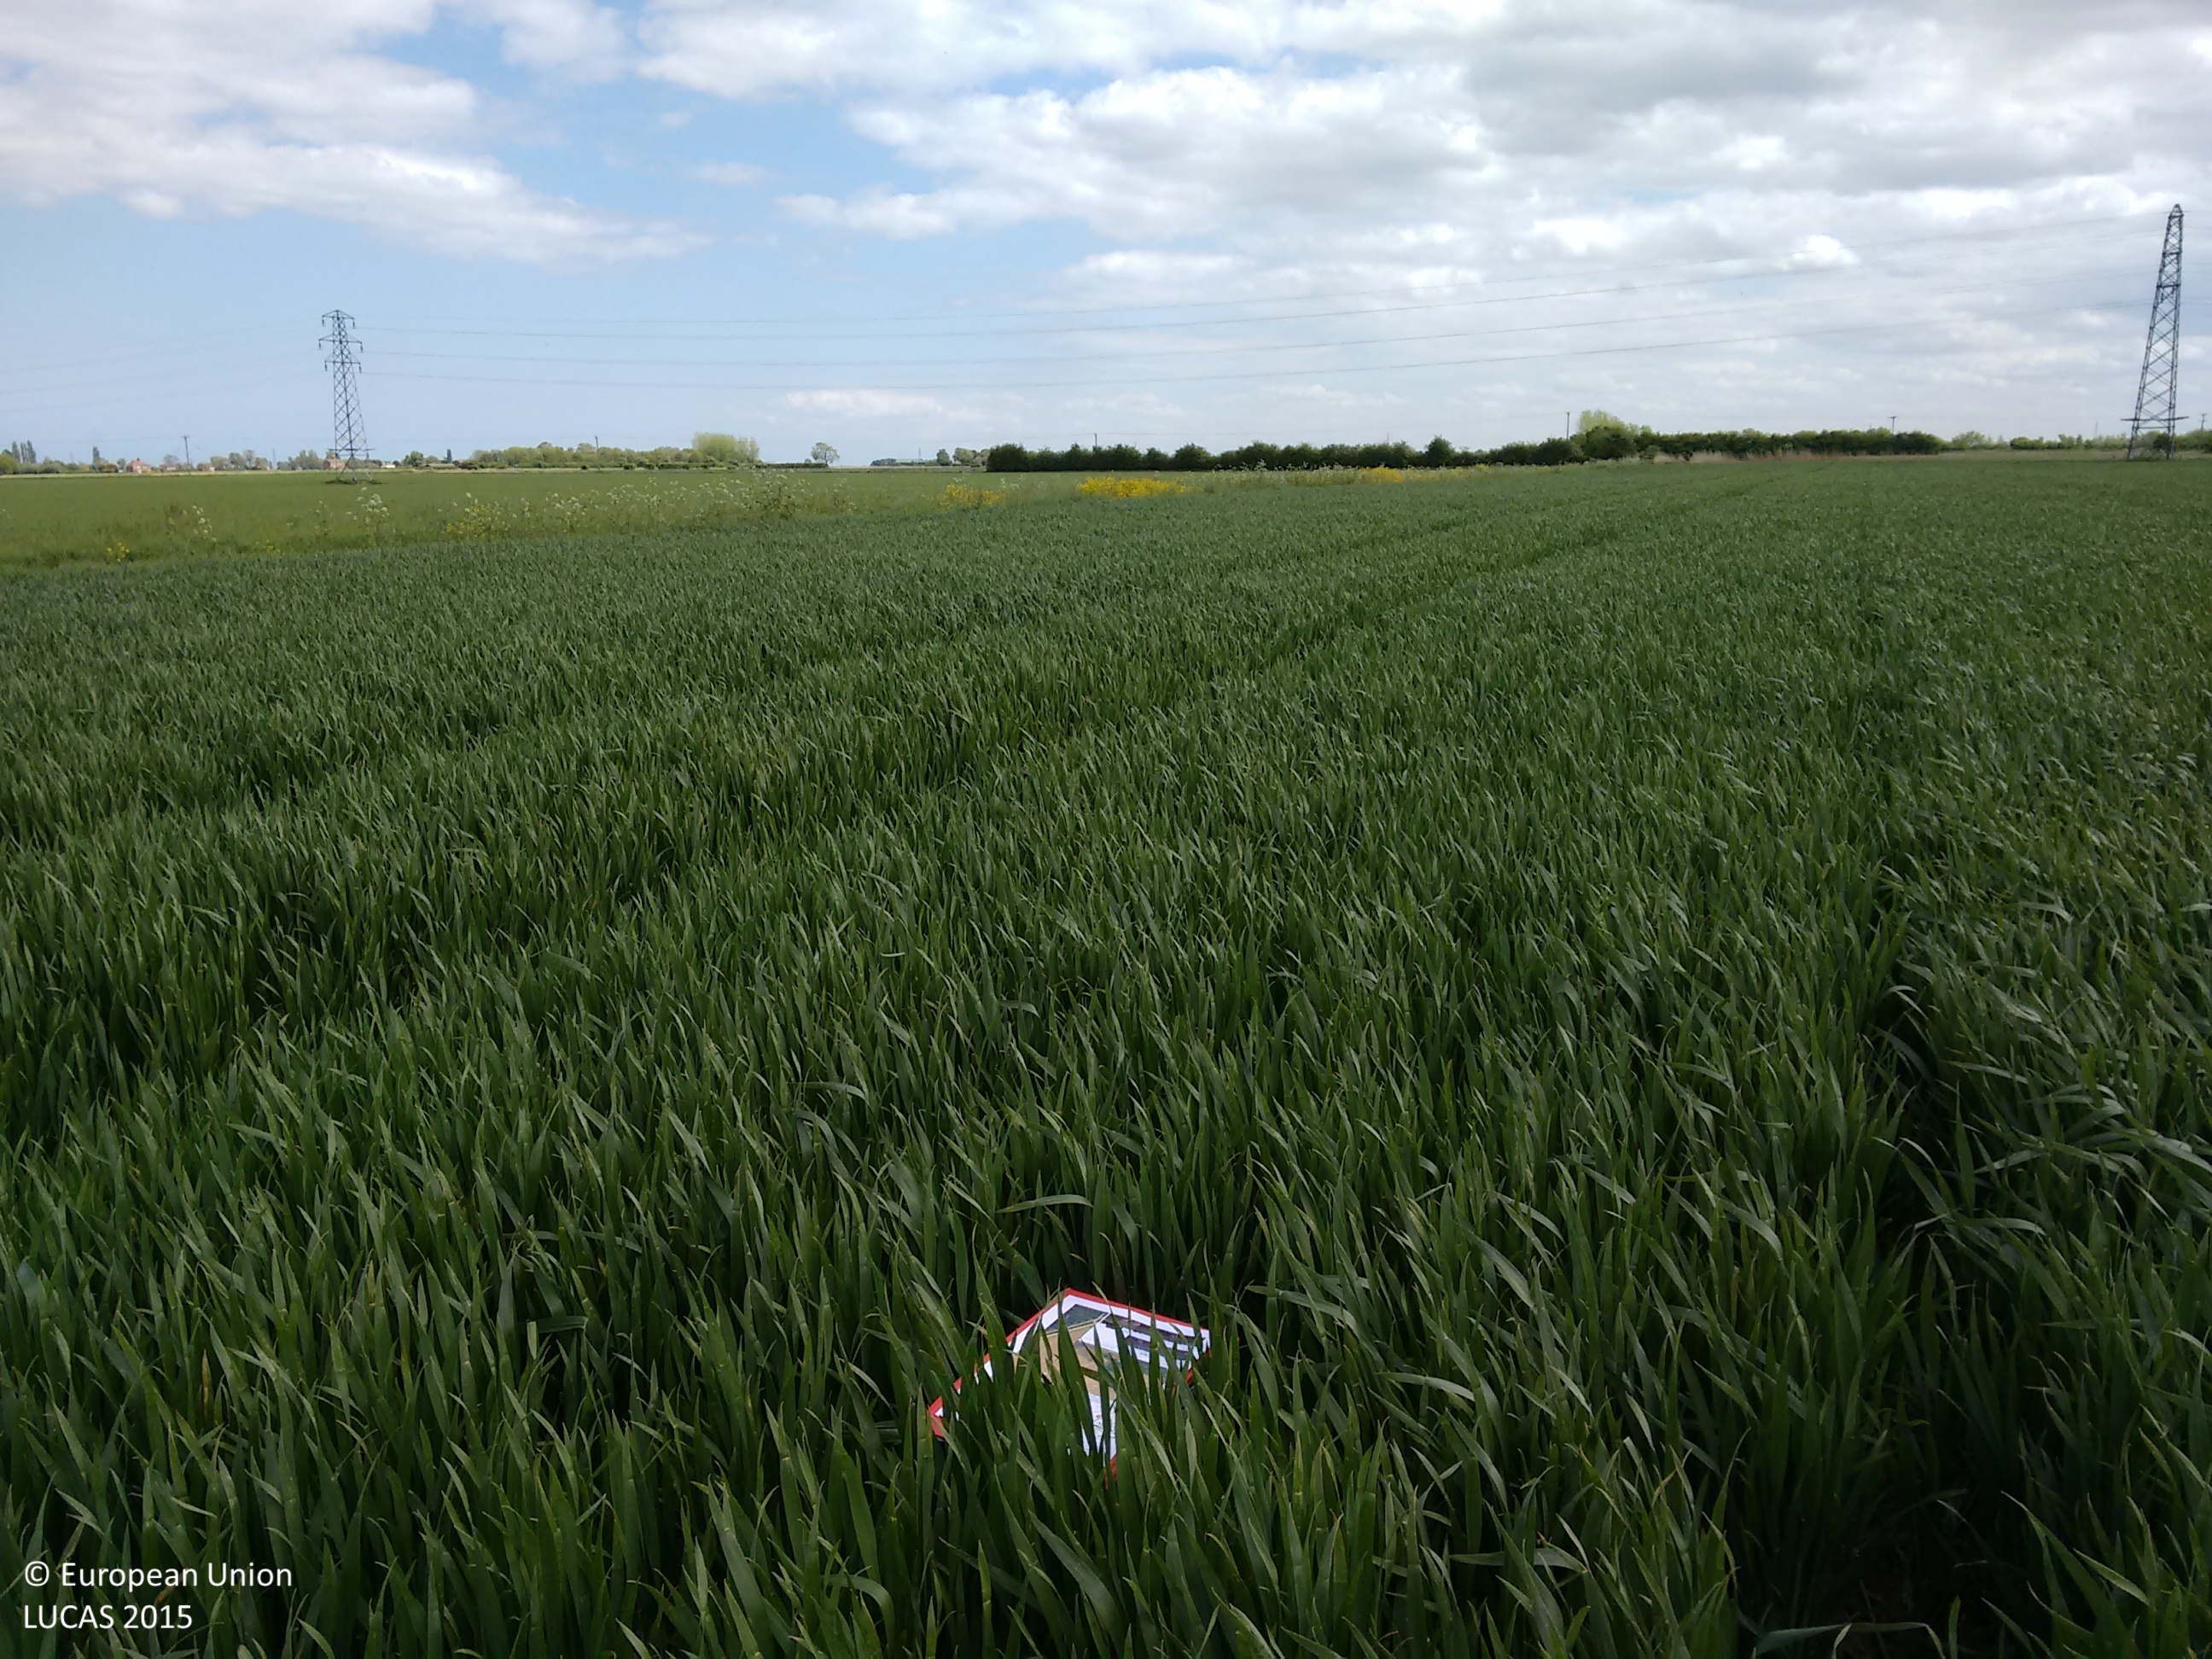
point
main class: Cropland
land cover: Common wheat
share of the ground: > 75 %
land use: Agriculture (excluding fallow land and kitchen gardens)
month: May
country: GB
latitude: 52.9112
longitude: -0.0402
